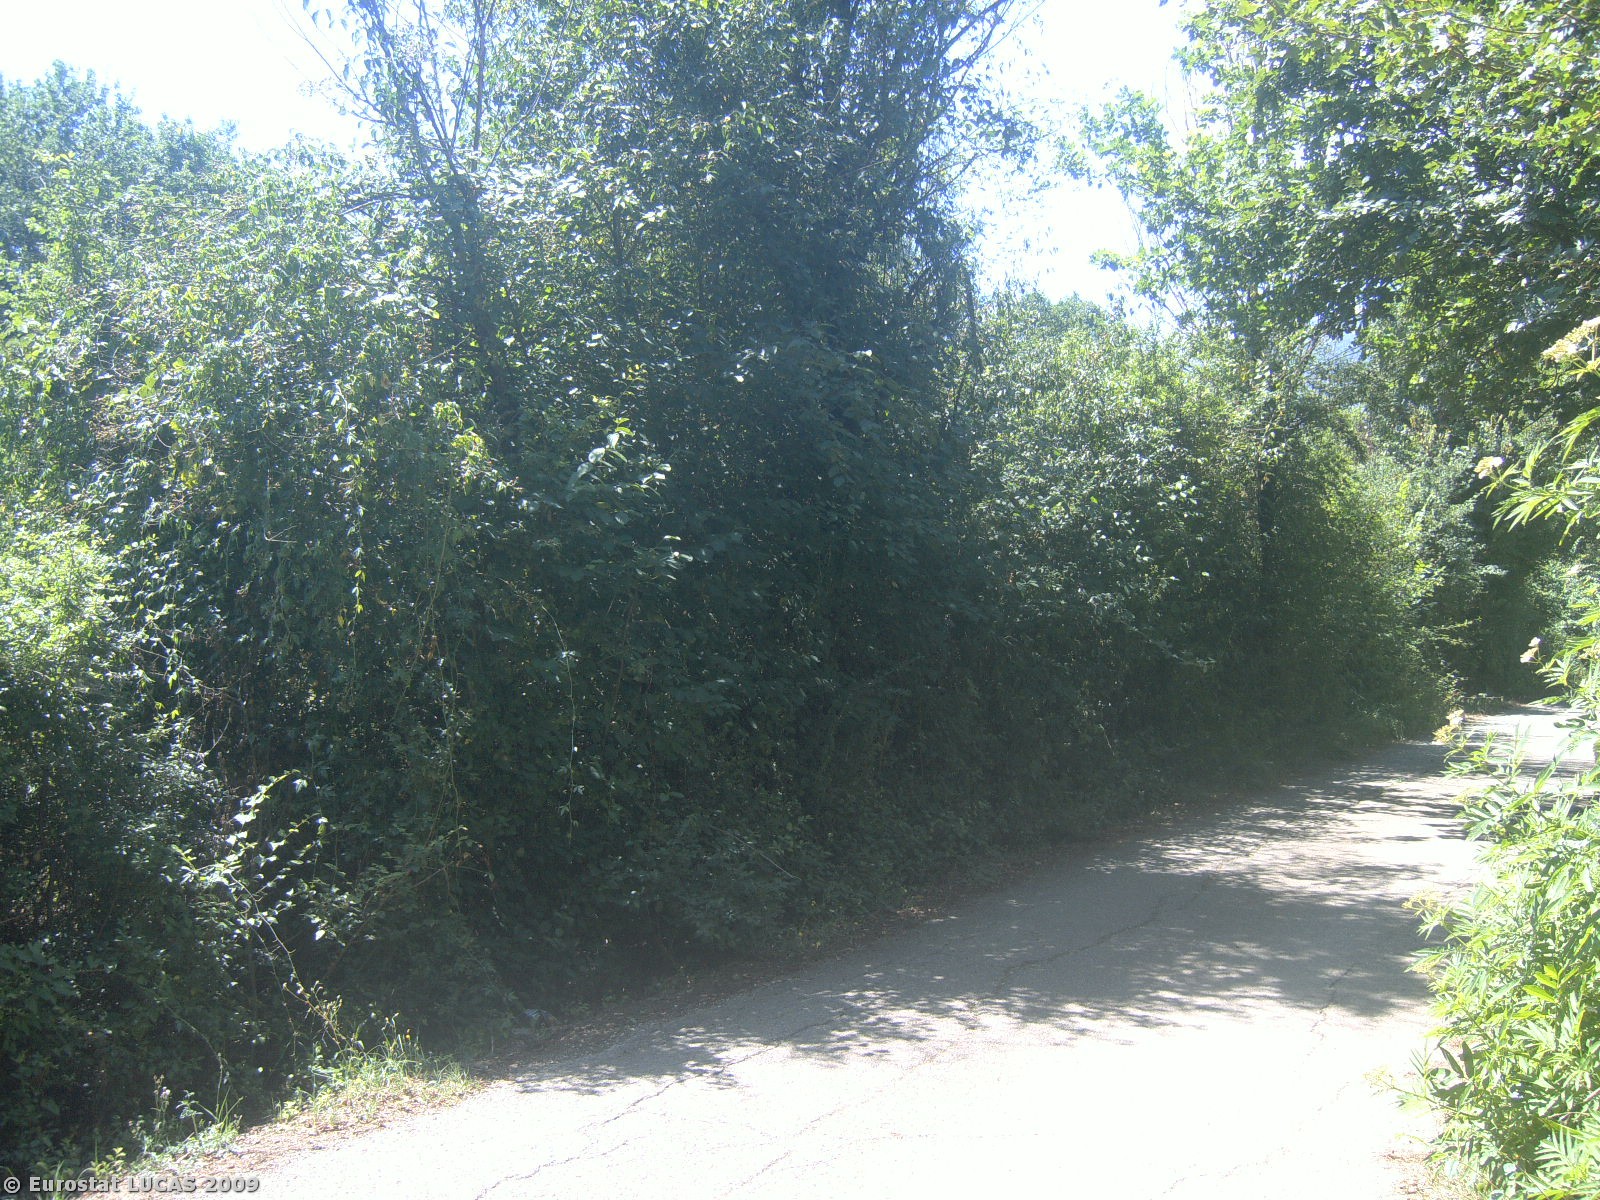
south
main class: Cropland
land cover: Other fresh vegetables
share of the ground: > 75 %
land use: Kitchen garden
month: July
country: IT
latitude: 41.6069
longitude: 13.2633
